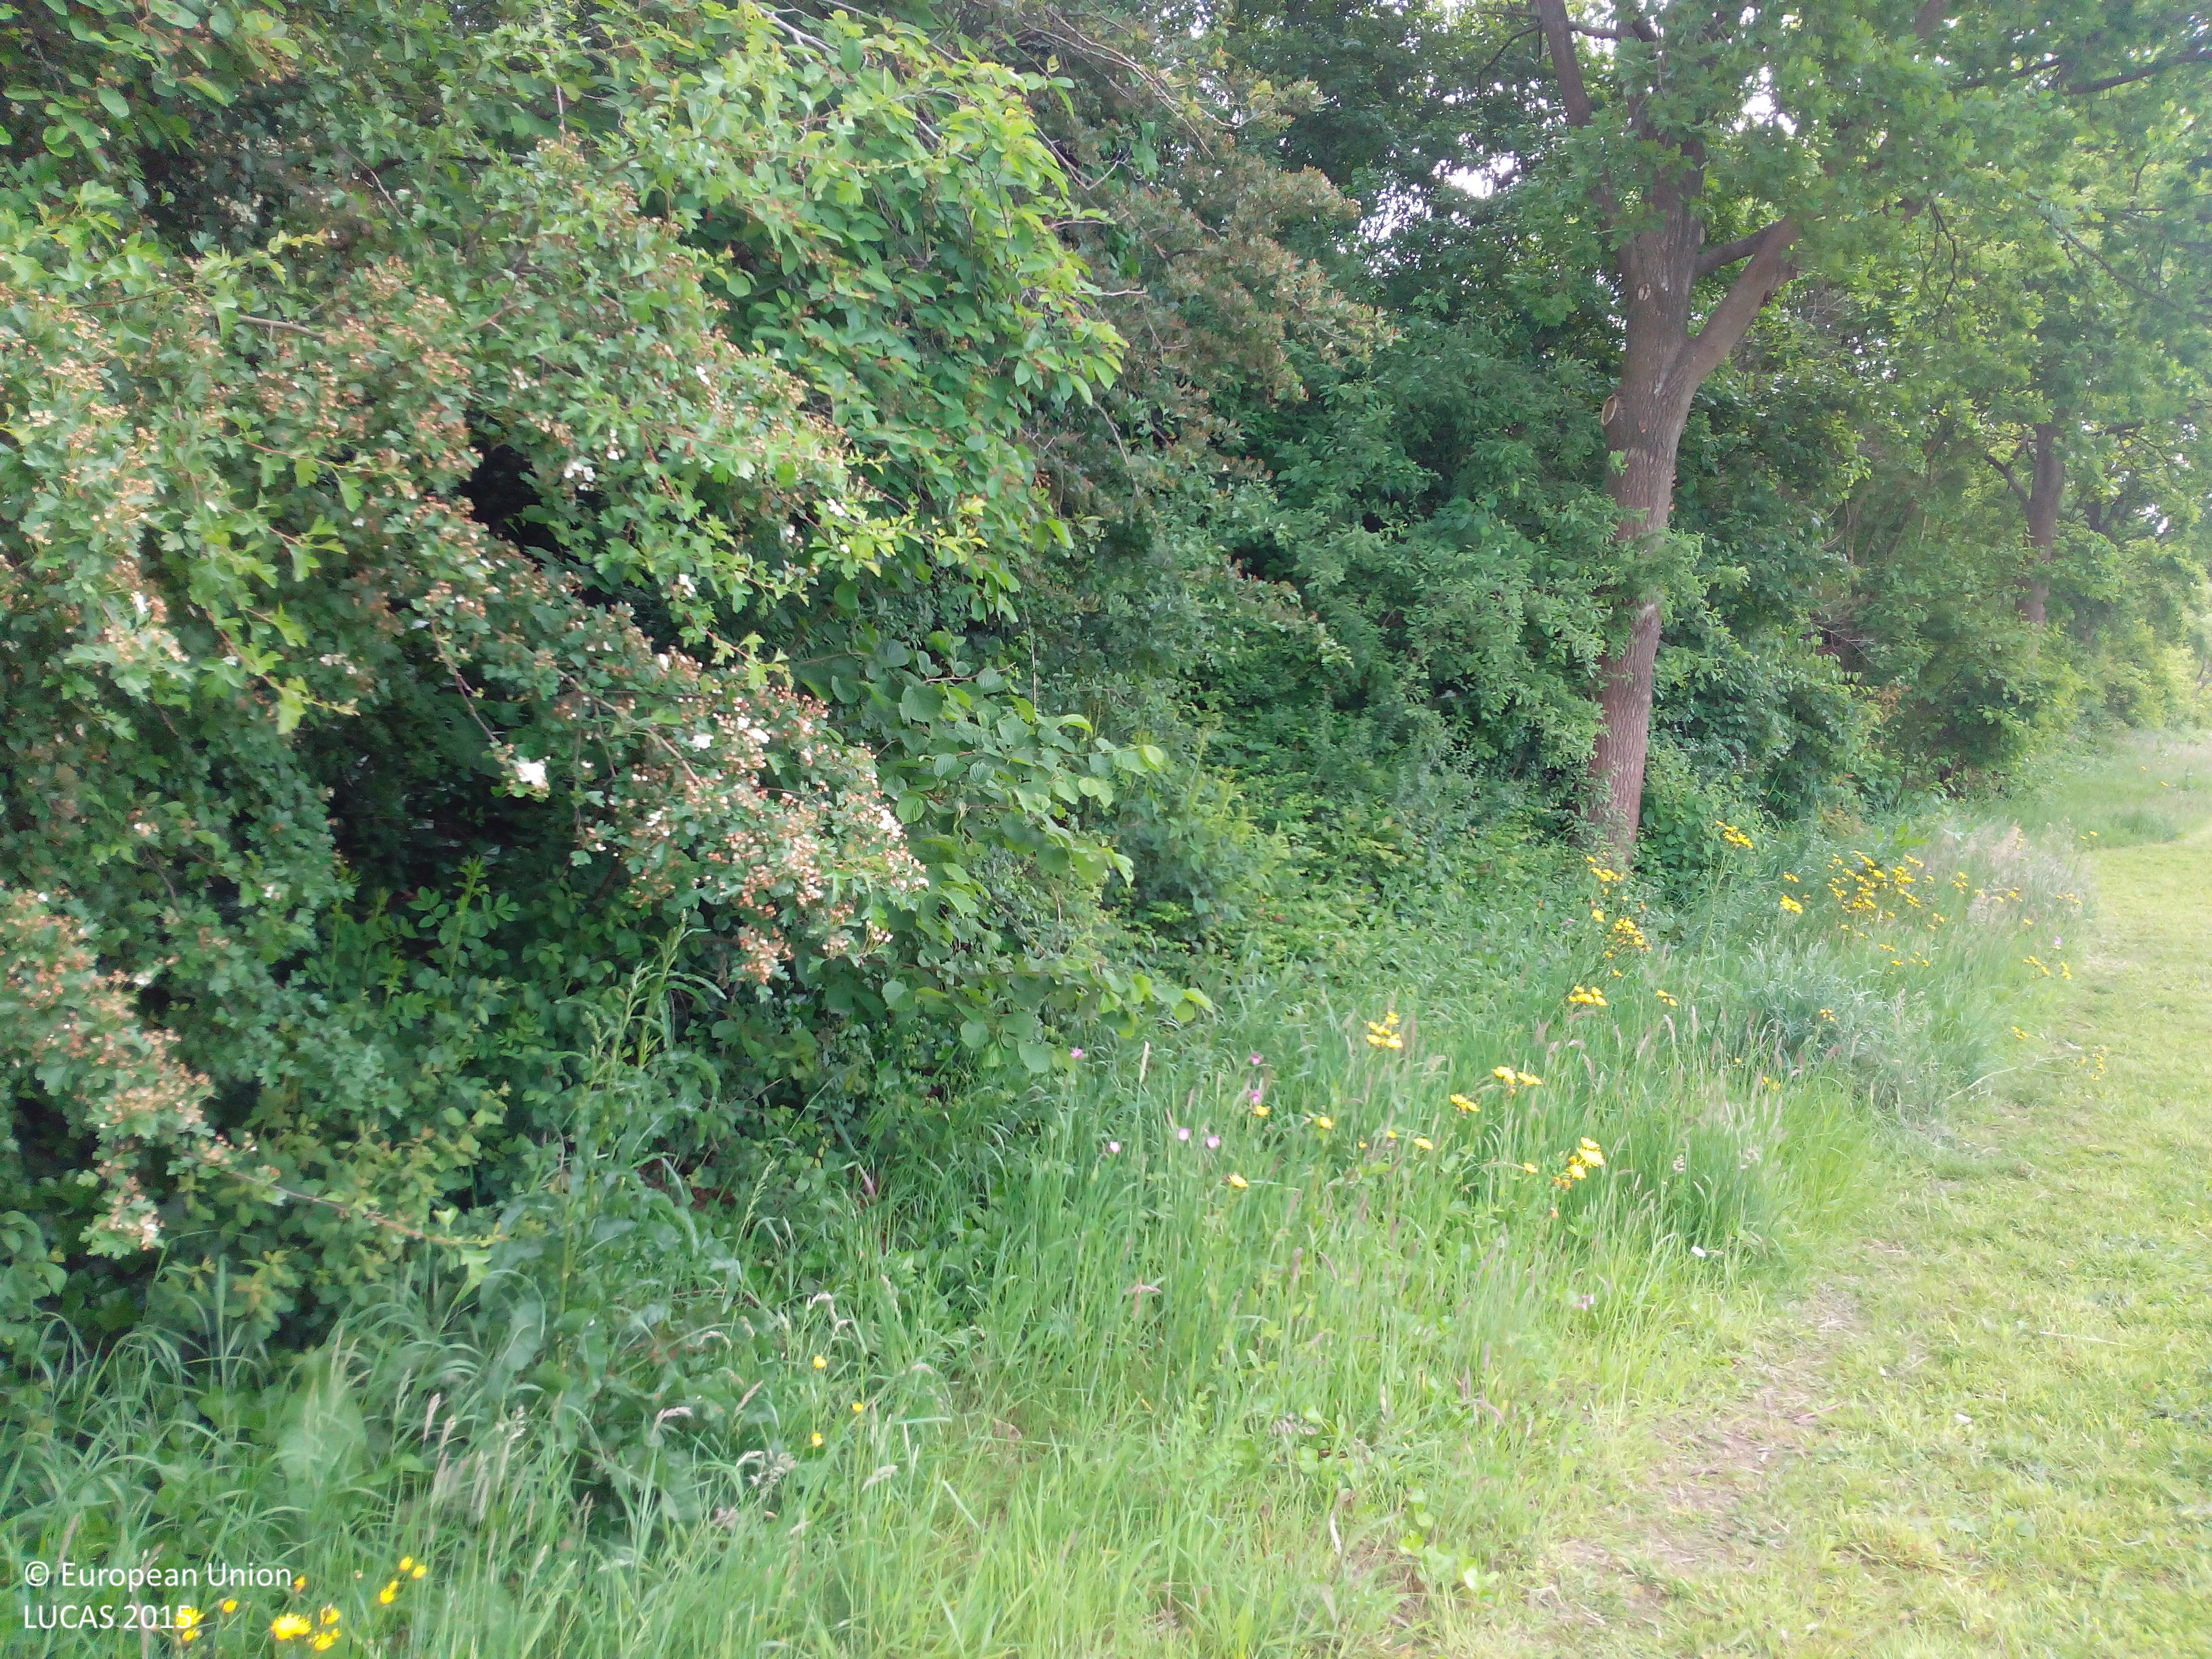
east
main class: Grassland
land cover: Grassland without tree/shrub cover
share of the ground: > 75 %
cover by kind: herbaceous plants 100 %
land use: Road transport
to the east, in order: Grassland without tree/shrub cover; Broadleaved woodland; Artificial constructions in urban areas
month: May
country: NL
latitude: 52.2449
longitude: 6.2061
